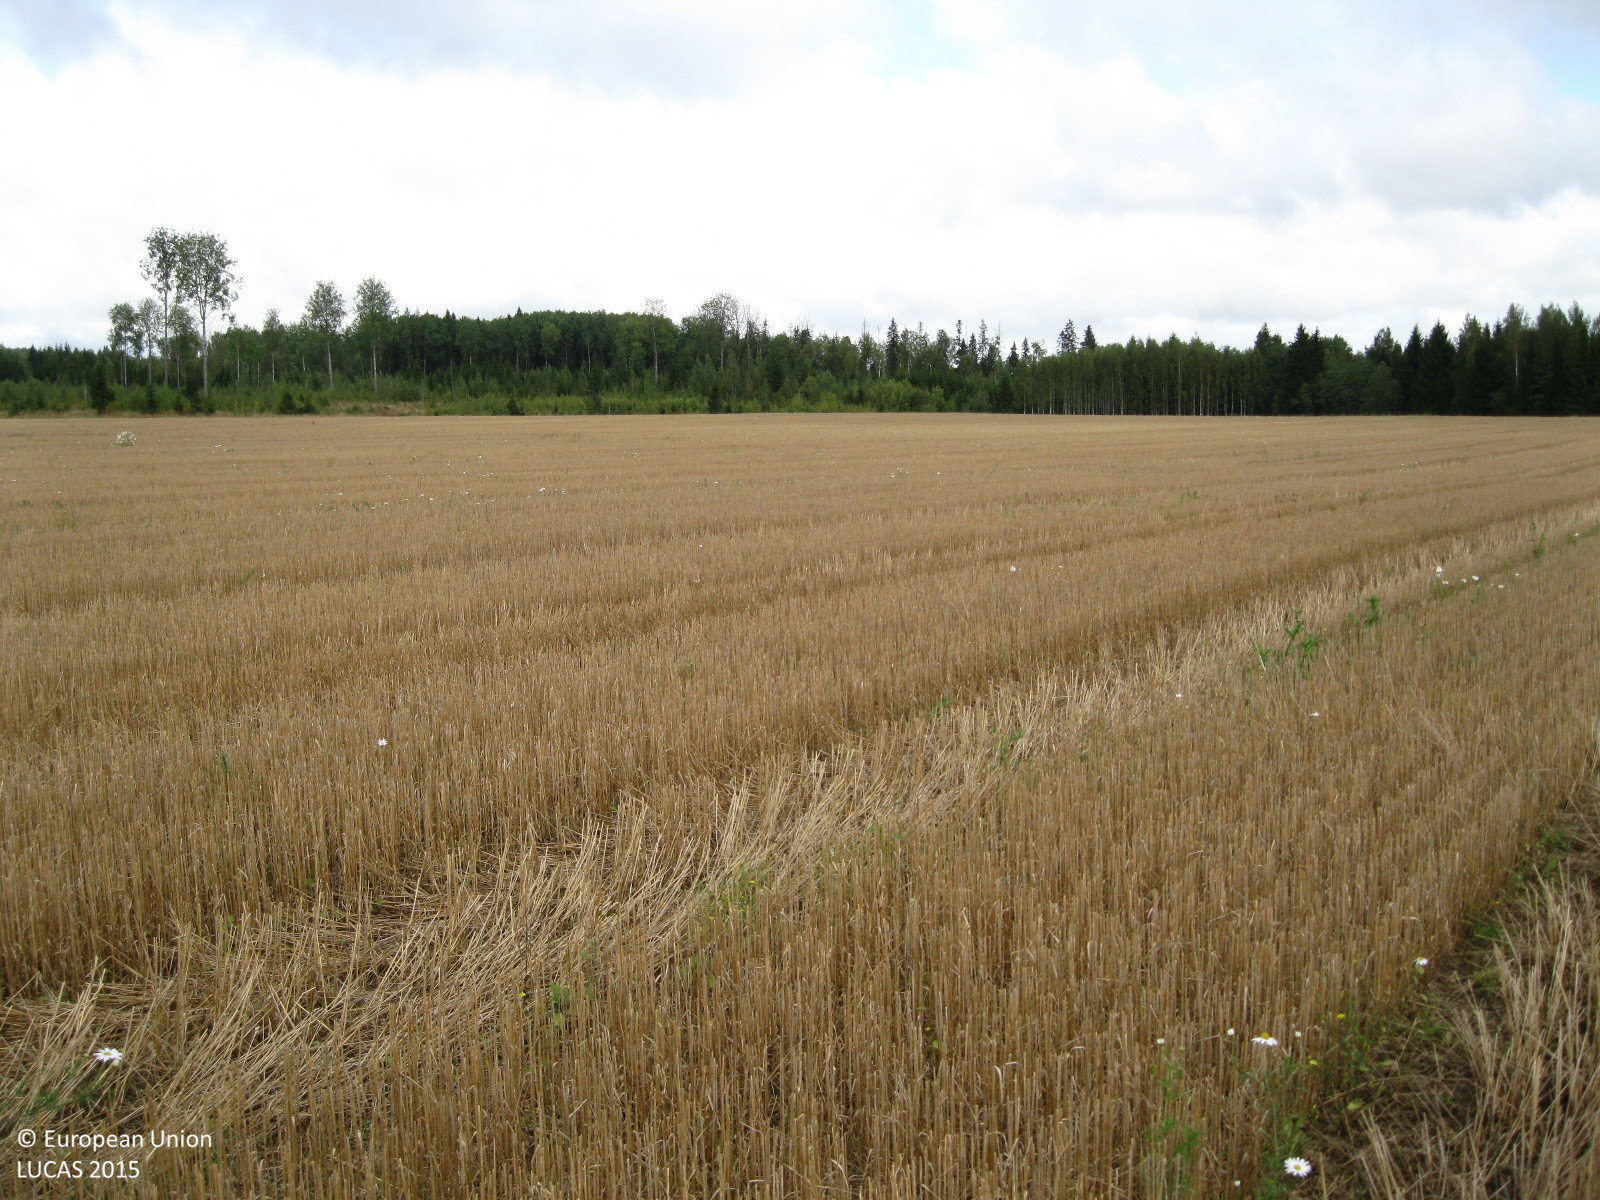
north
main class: Cropland
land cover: Common wheat
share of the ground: > 75 %
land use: Agriculture (excluding fallow land and kitchen gardens)
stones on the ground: < 10 %
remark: Harvested field
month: September
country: FI
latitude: 60.4353
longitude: 24.8498
